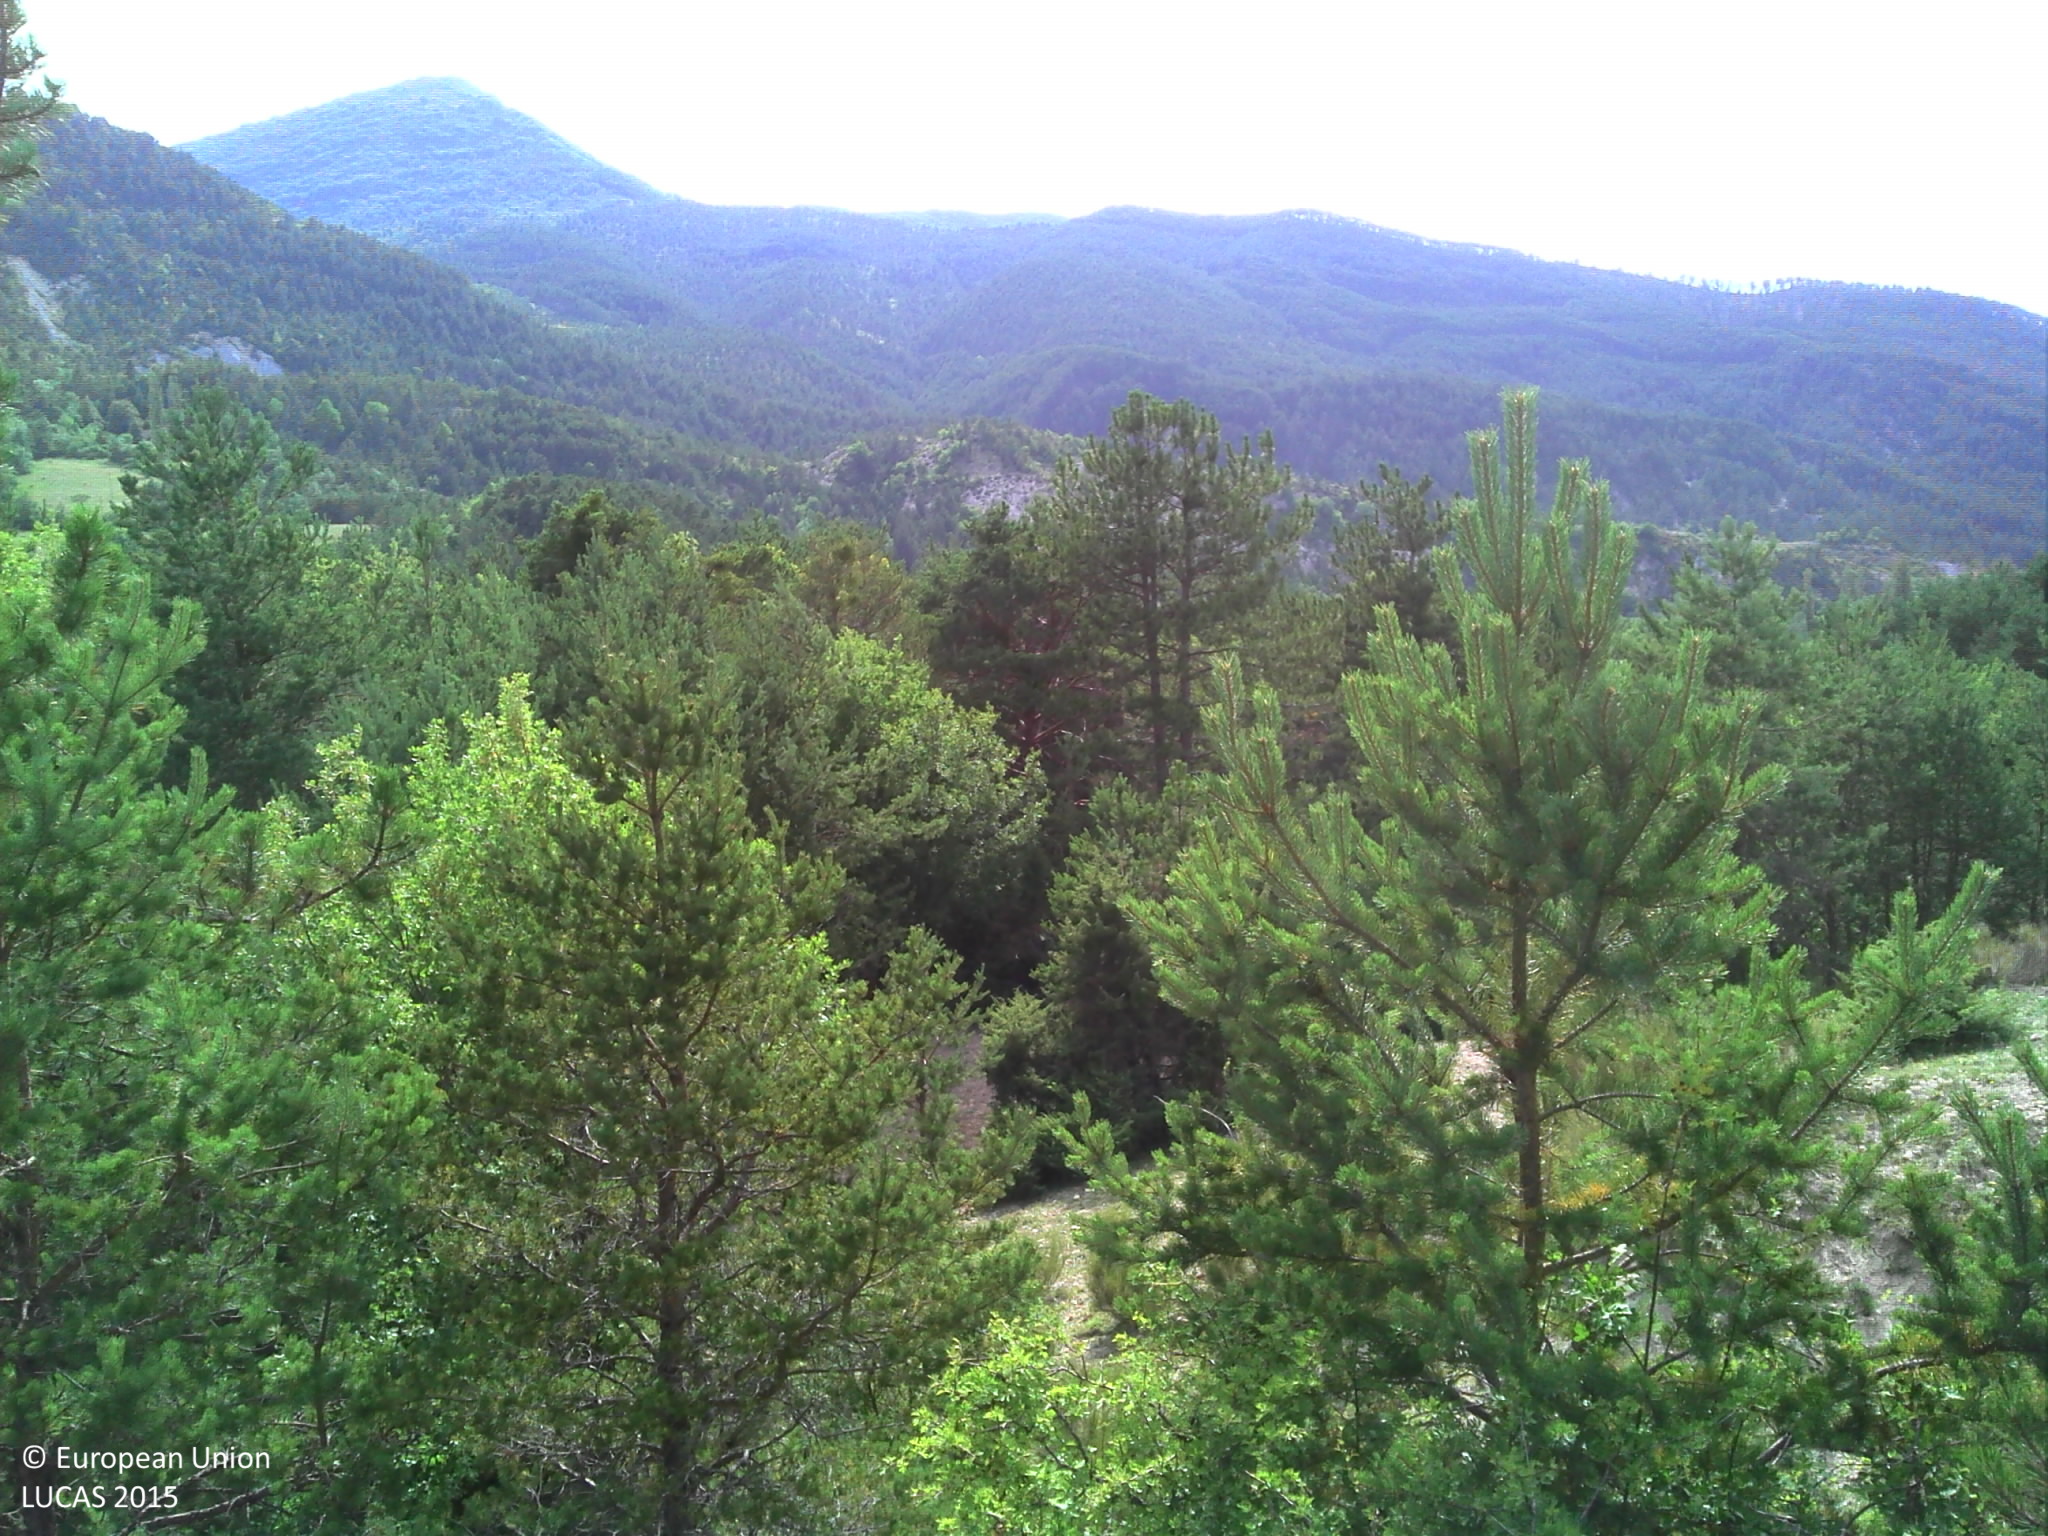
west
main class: Shrubland
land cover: Shrubland with sparse tree cover
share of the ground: > 75 %
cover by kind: shrubs 50 %, consolidated bare surface 35 %, herbaceous plants 10 %, broadleaved forest trees 5 %
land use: Agriculture (excluding fallow land and kitchen gardens)
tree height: > 5 m
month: July
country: FR
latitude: 43.9445
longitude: 6.3820
